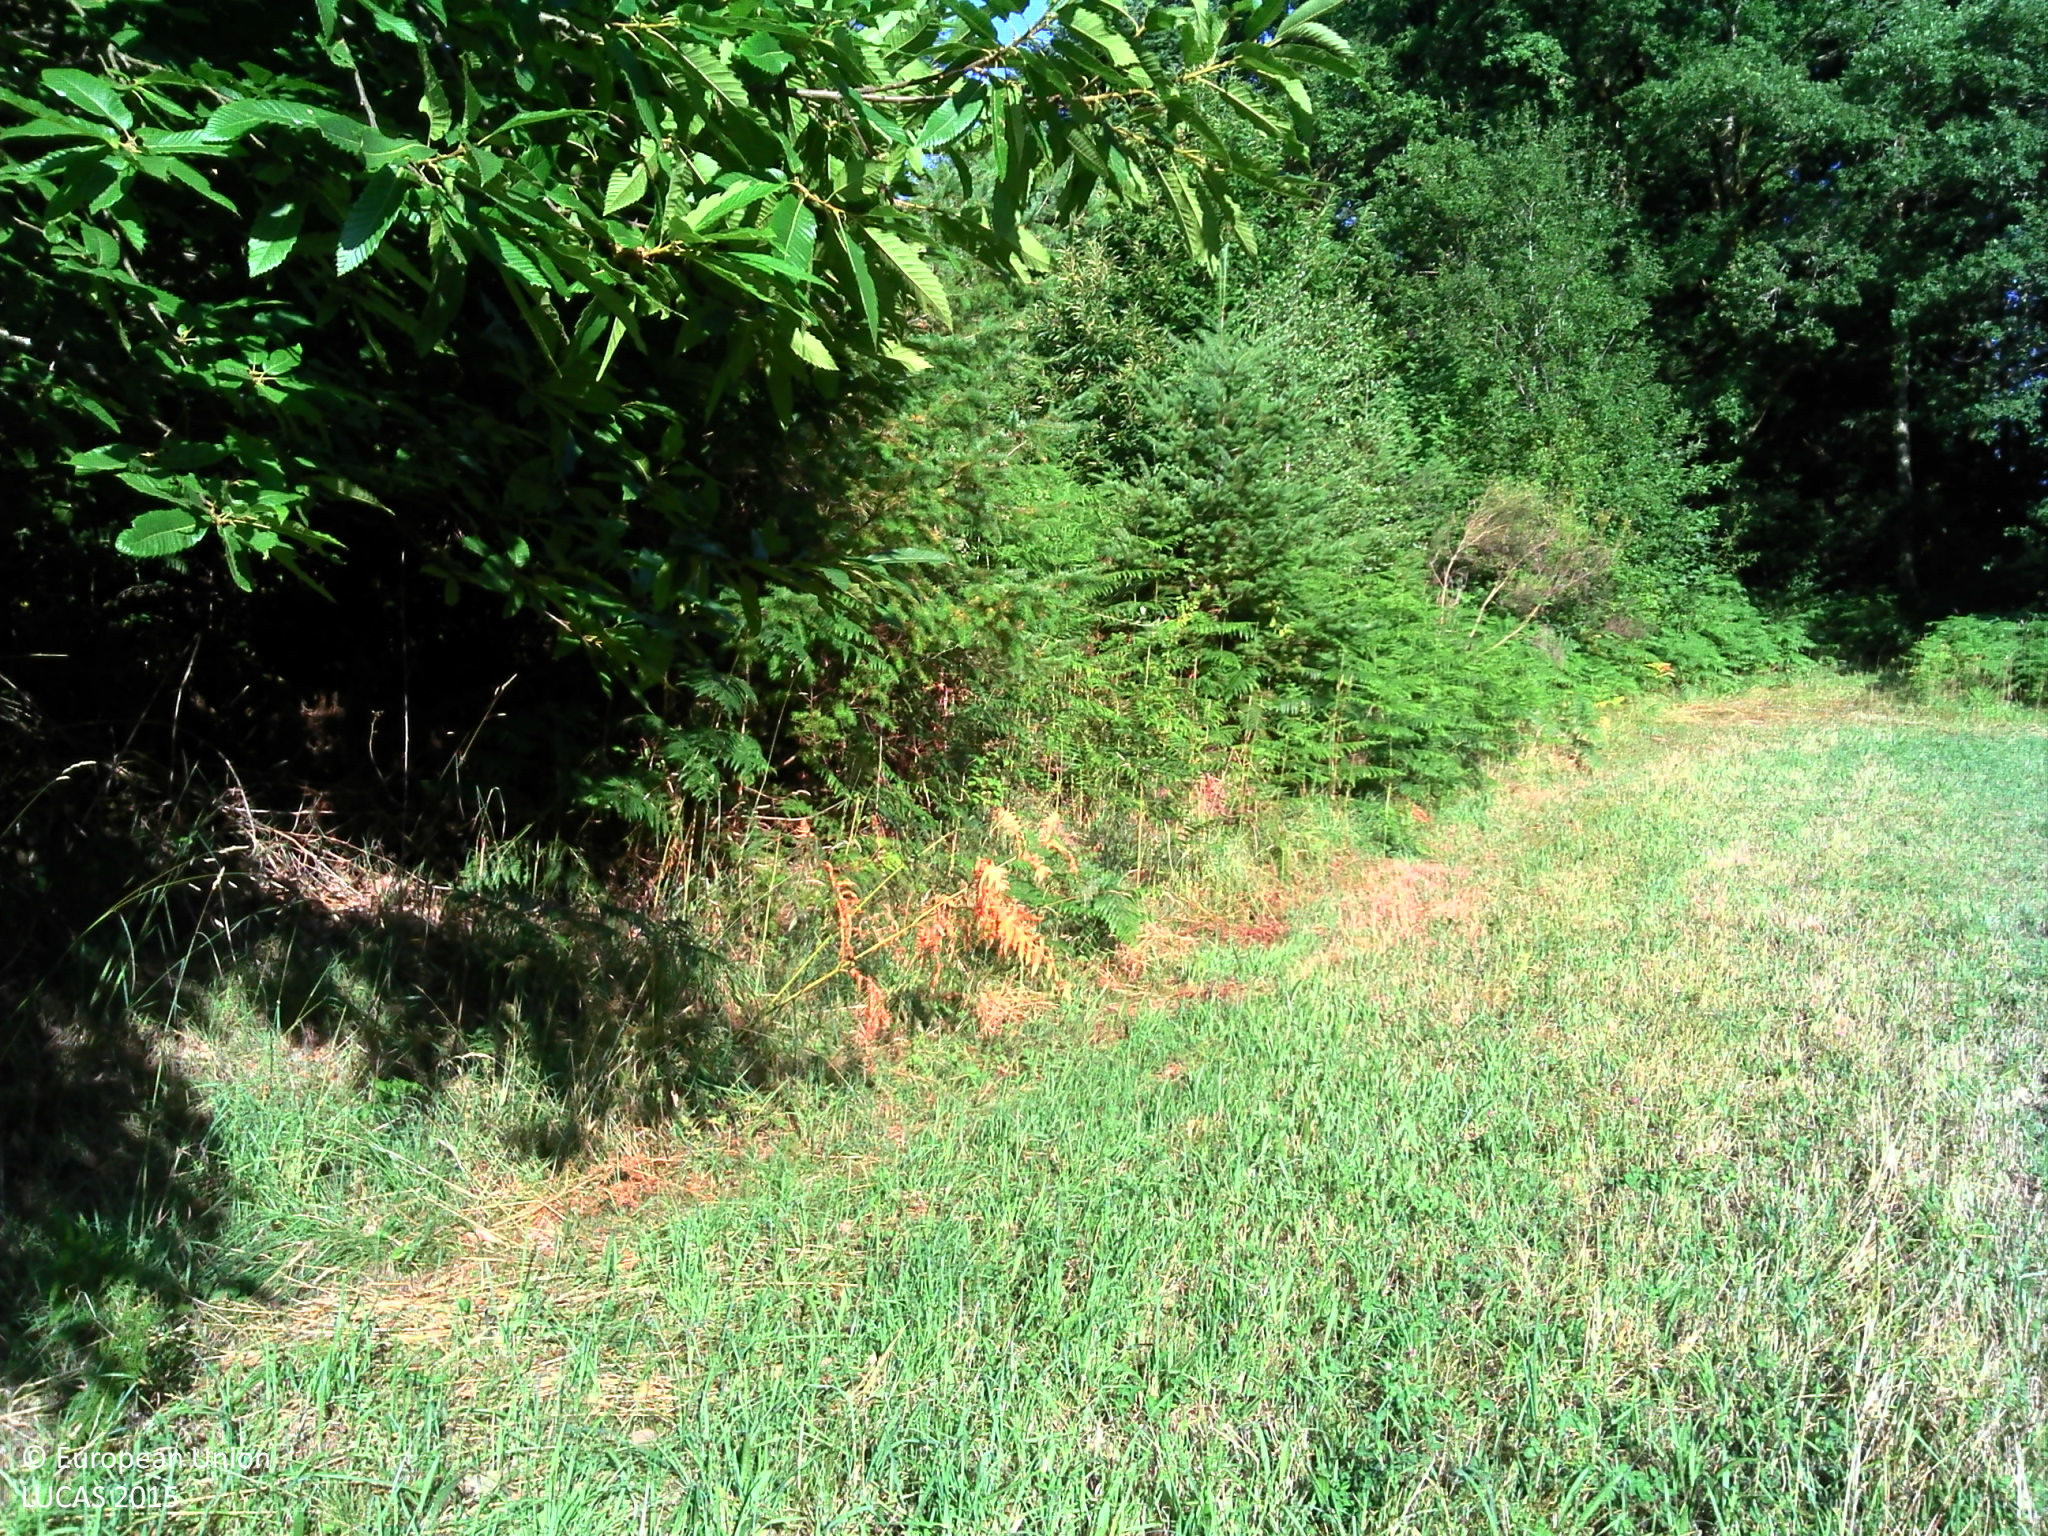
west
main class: Cropland
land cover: Temporary grasslands
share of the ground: > 75 %
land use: Agriculture (excluding fallow land and kitchen gardens)
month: July
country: FR
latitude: 45.7289
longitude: 1.8091
